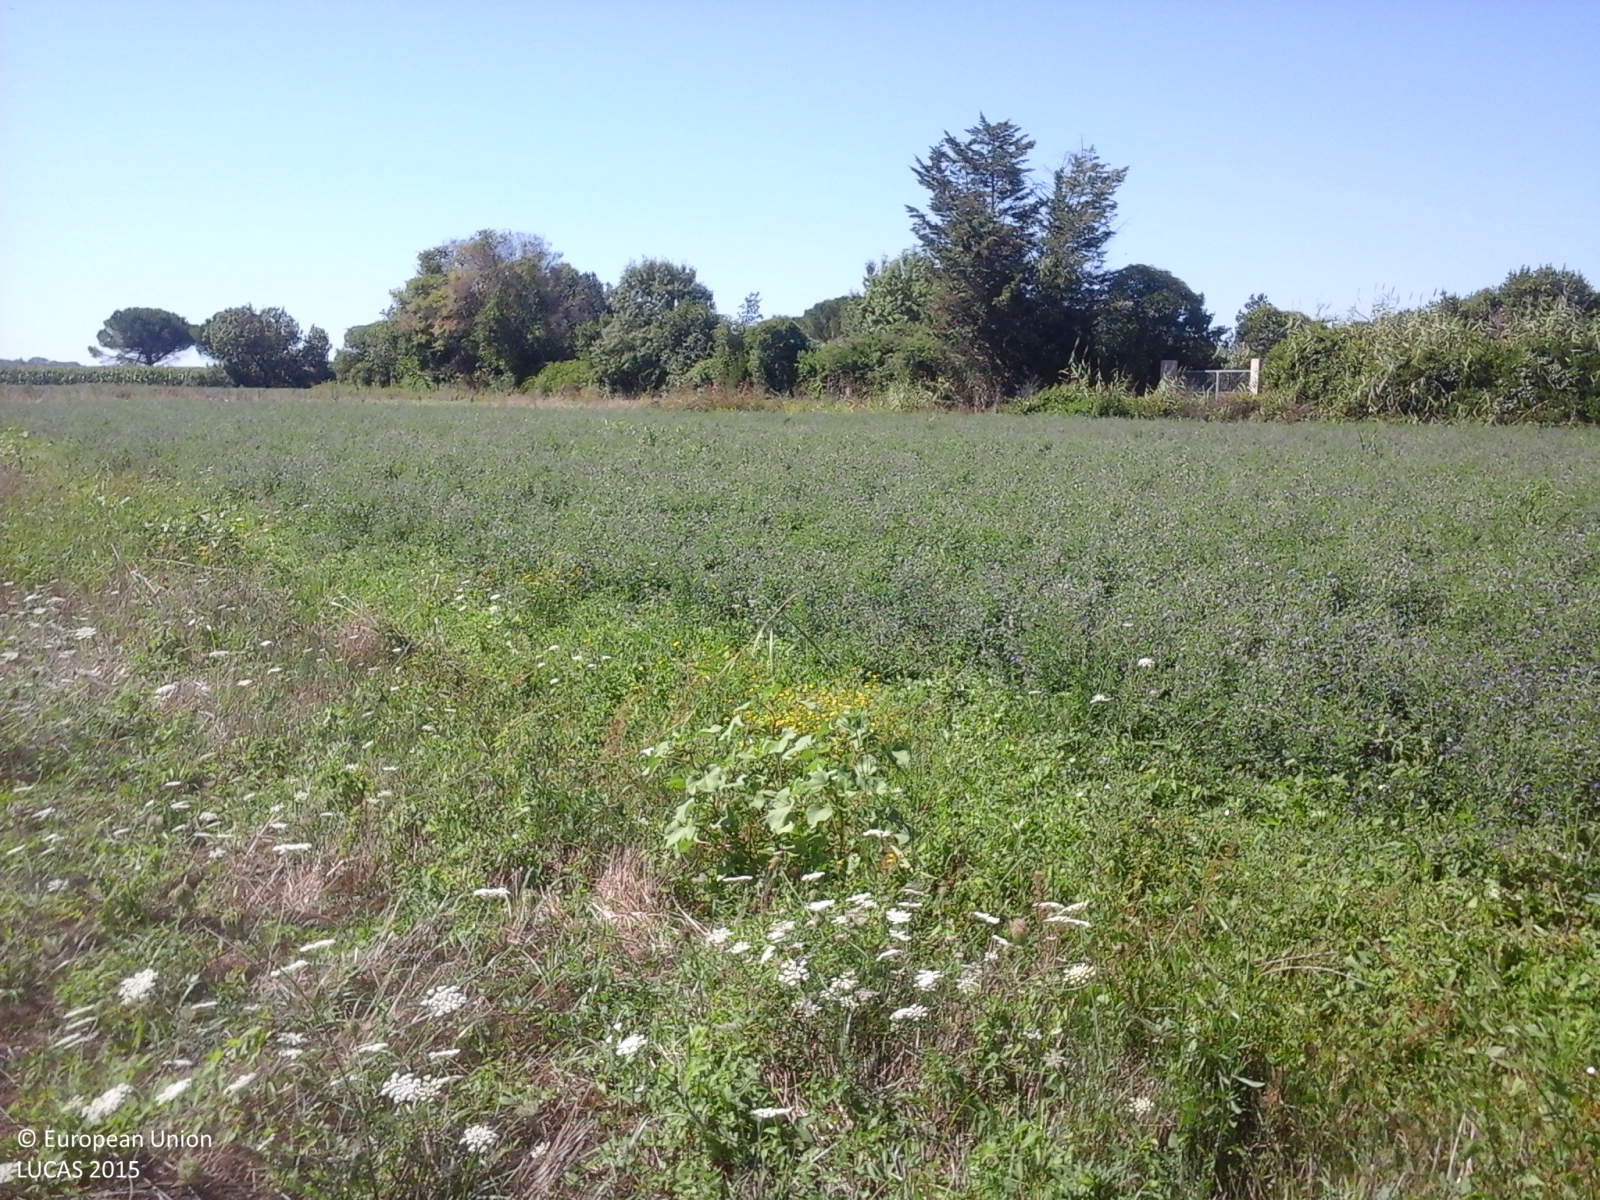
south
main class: Grassland
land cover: Spontaneously vegetated surfaces
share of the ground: > 75 %
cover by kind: herbaceous plants 100 %
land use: Agriculture (excluding fallow land and kitchen gardens)
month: August
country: IT
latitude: 43.7185
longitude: 10.3590
